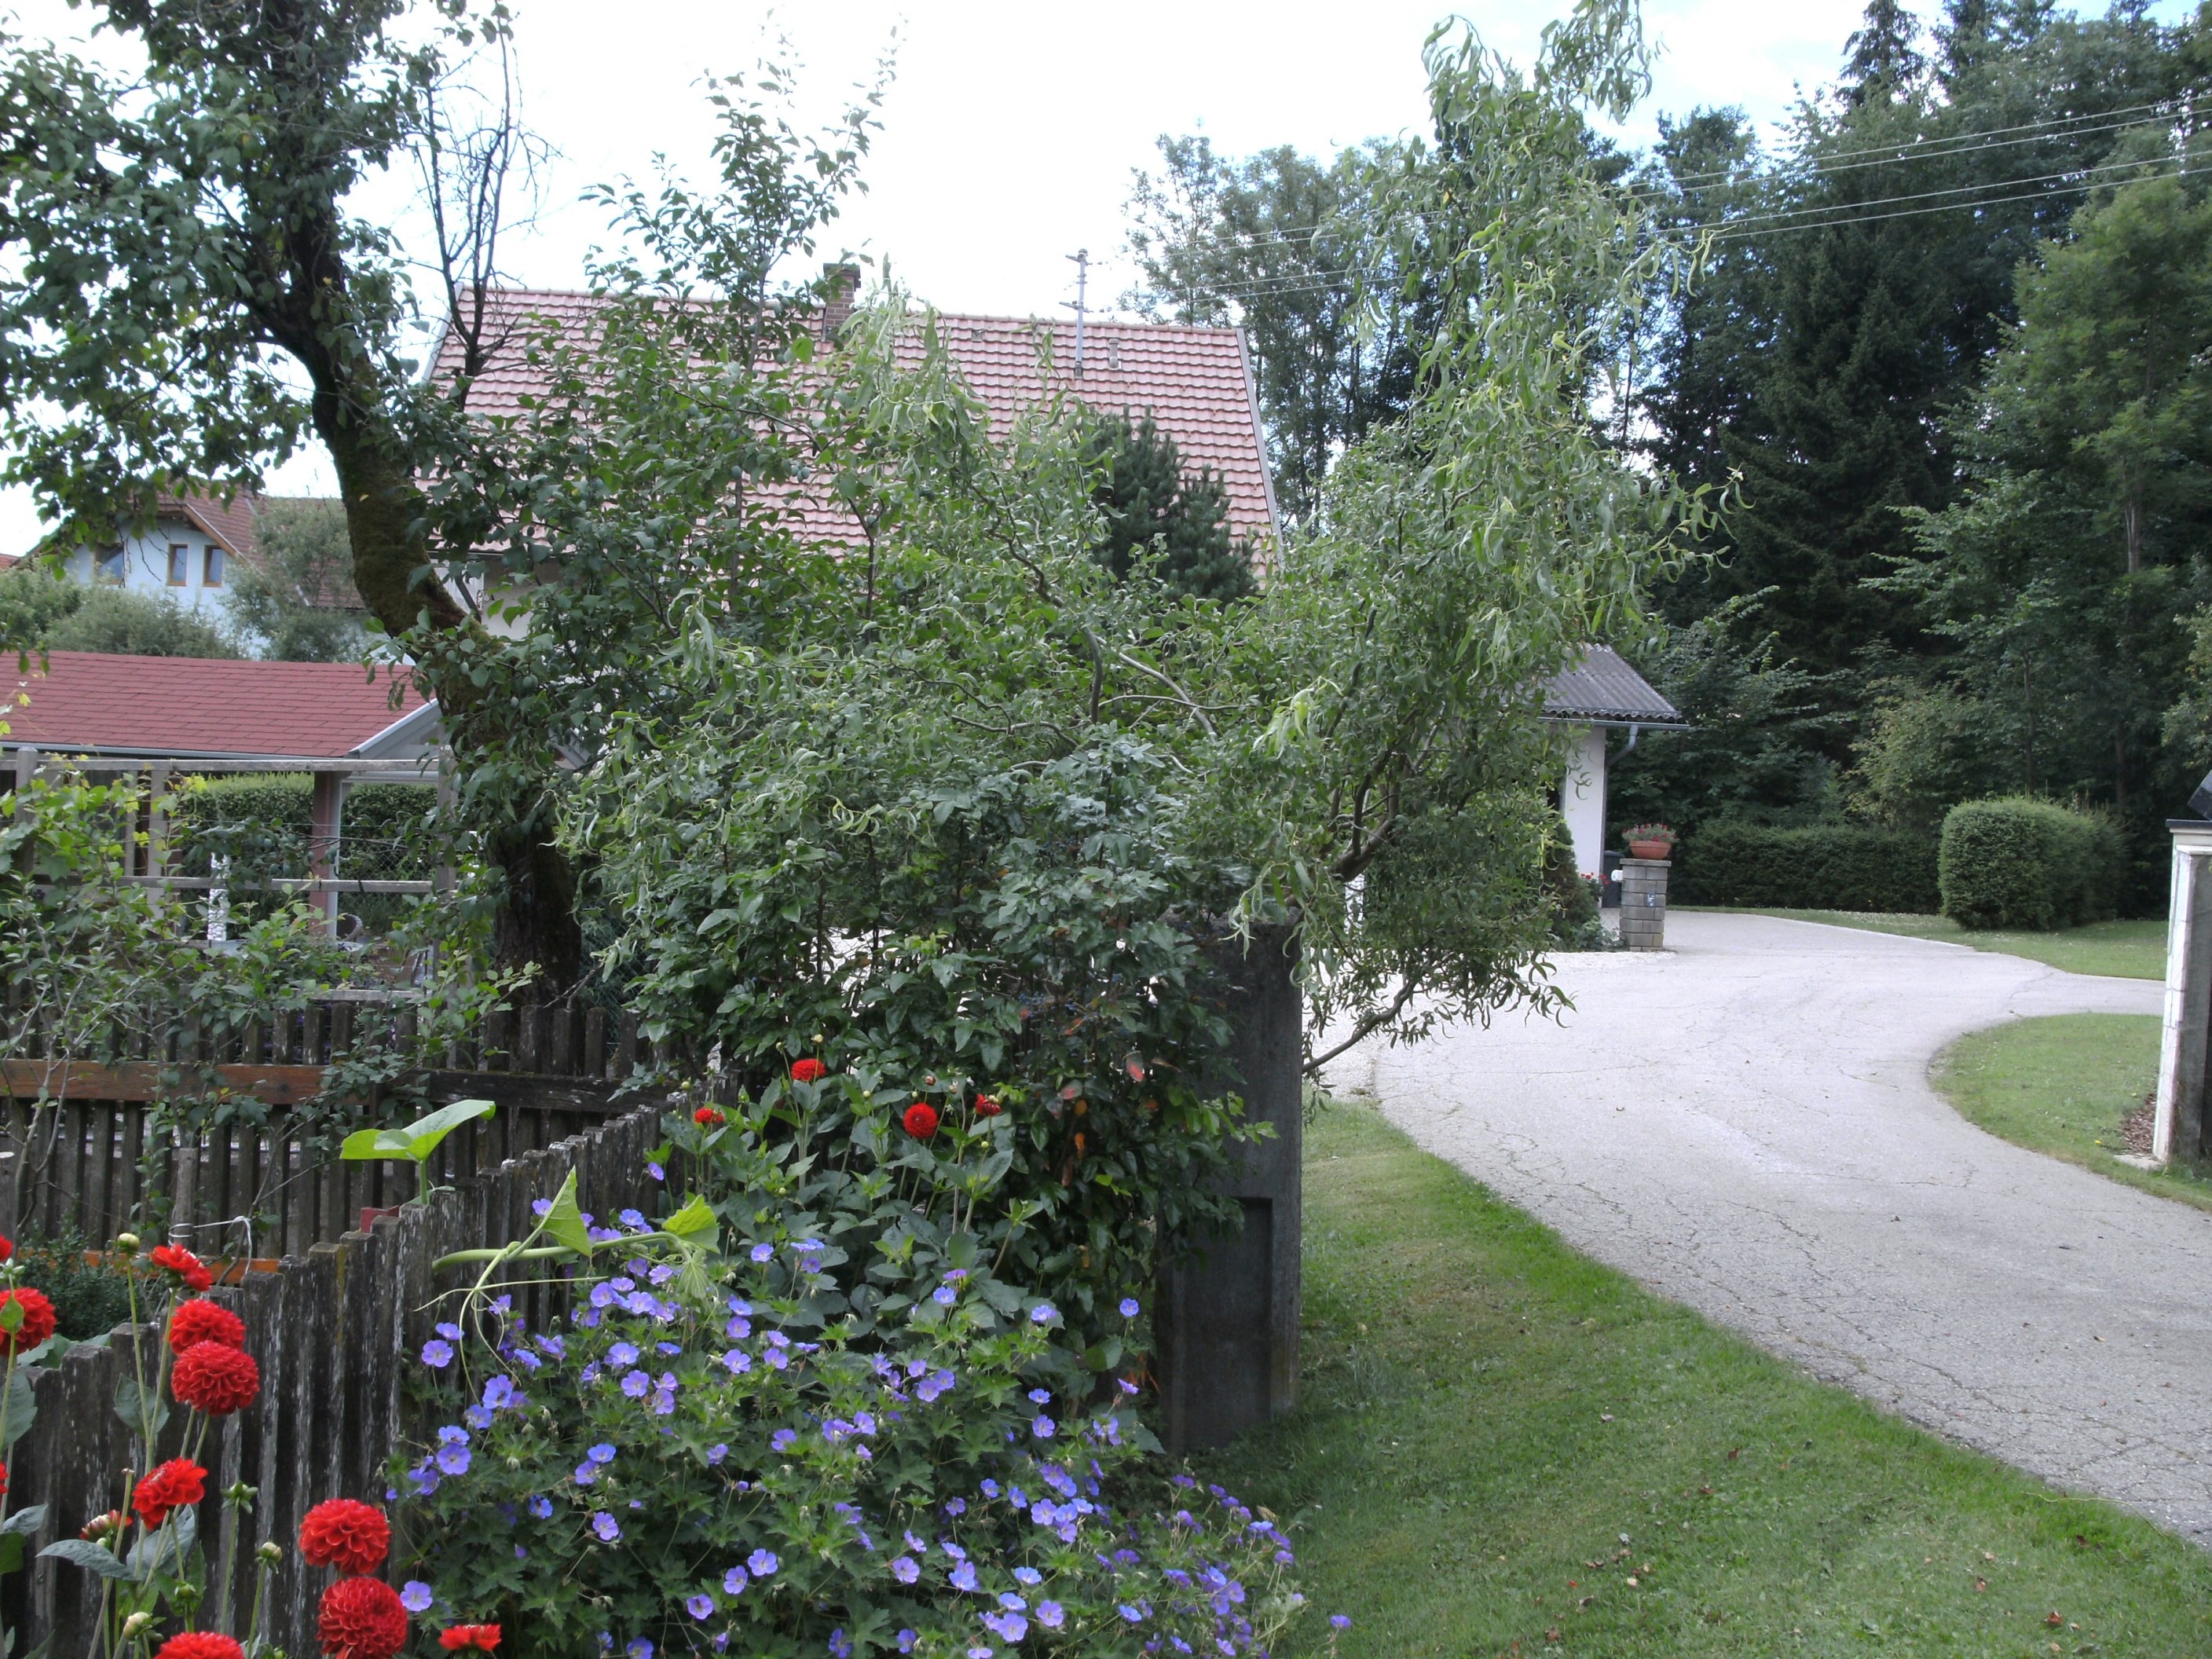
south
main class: Cropland
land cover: Apple fruit
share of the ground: 50 - 75 %
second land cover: Grassland without tree/shrub cover
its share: 25 - 50 %
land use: Agriculture (excluding fallow land and kitchen gardens)
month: July
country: AT
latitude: 46.8395
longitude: 14.7842
